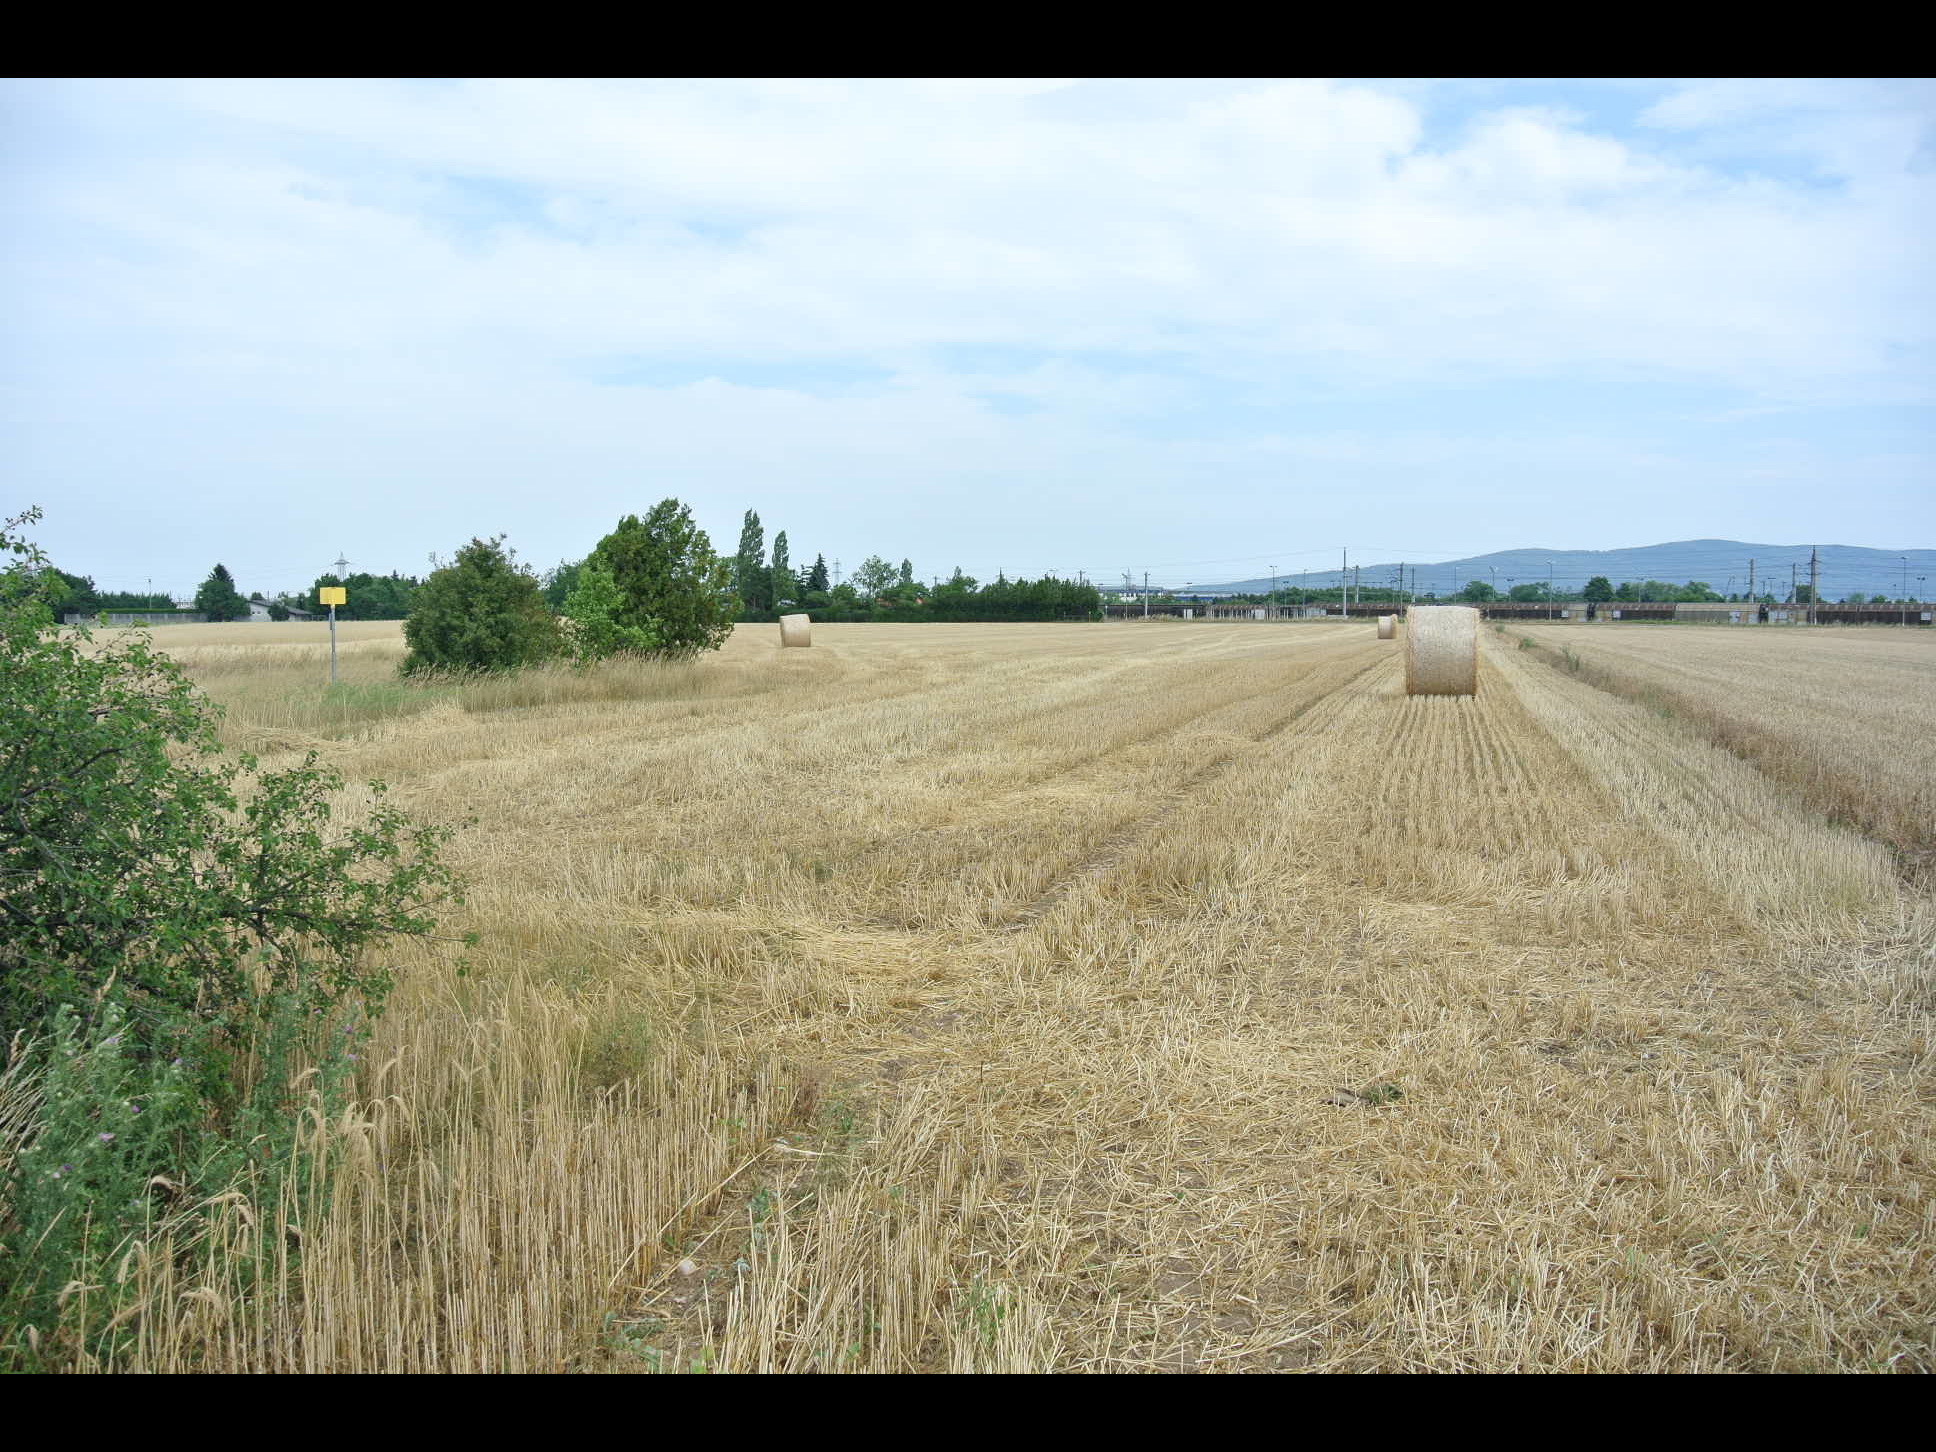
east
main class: Cropland
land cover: Common wheat
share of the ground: > 75 %
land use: Agriculture (excluding fallow land and kitchen gardens)
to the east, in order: Common wheat; Shrubland without tree cover; Common wheat
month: July
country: AT
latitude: 47.7957
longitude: 16.2113
